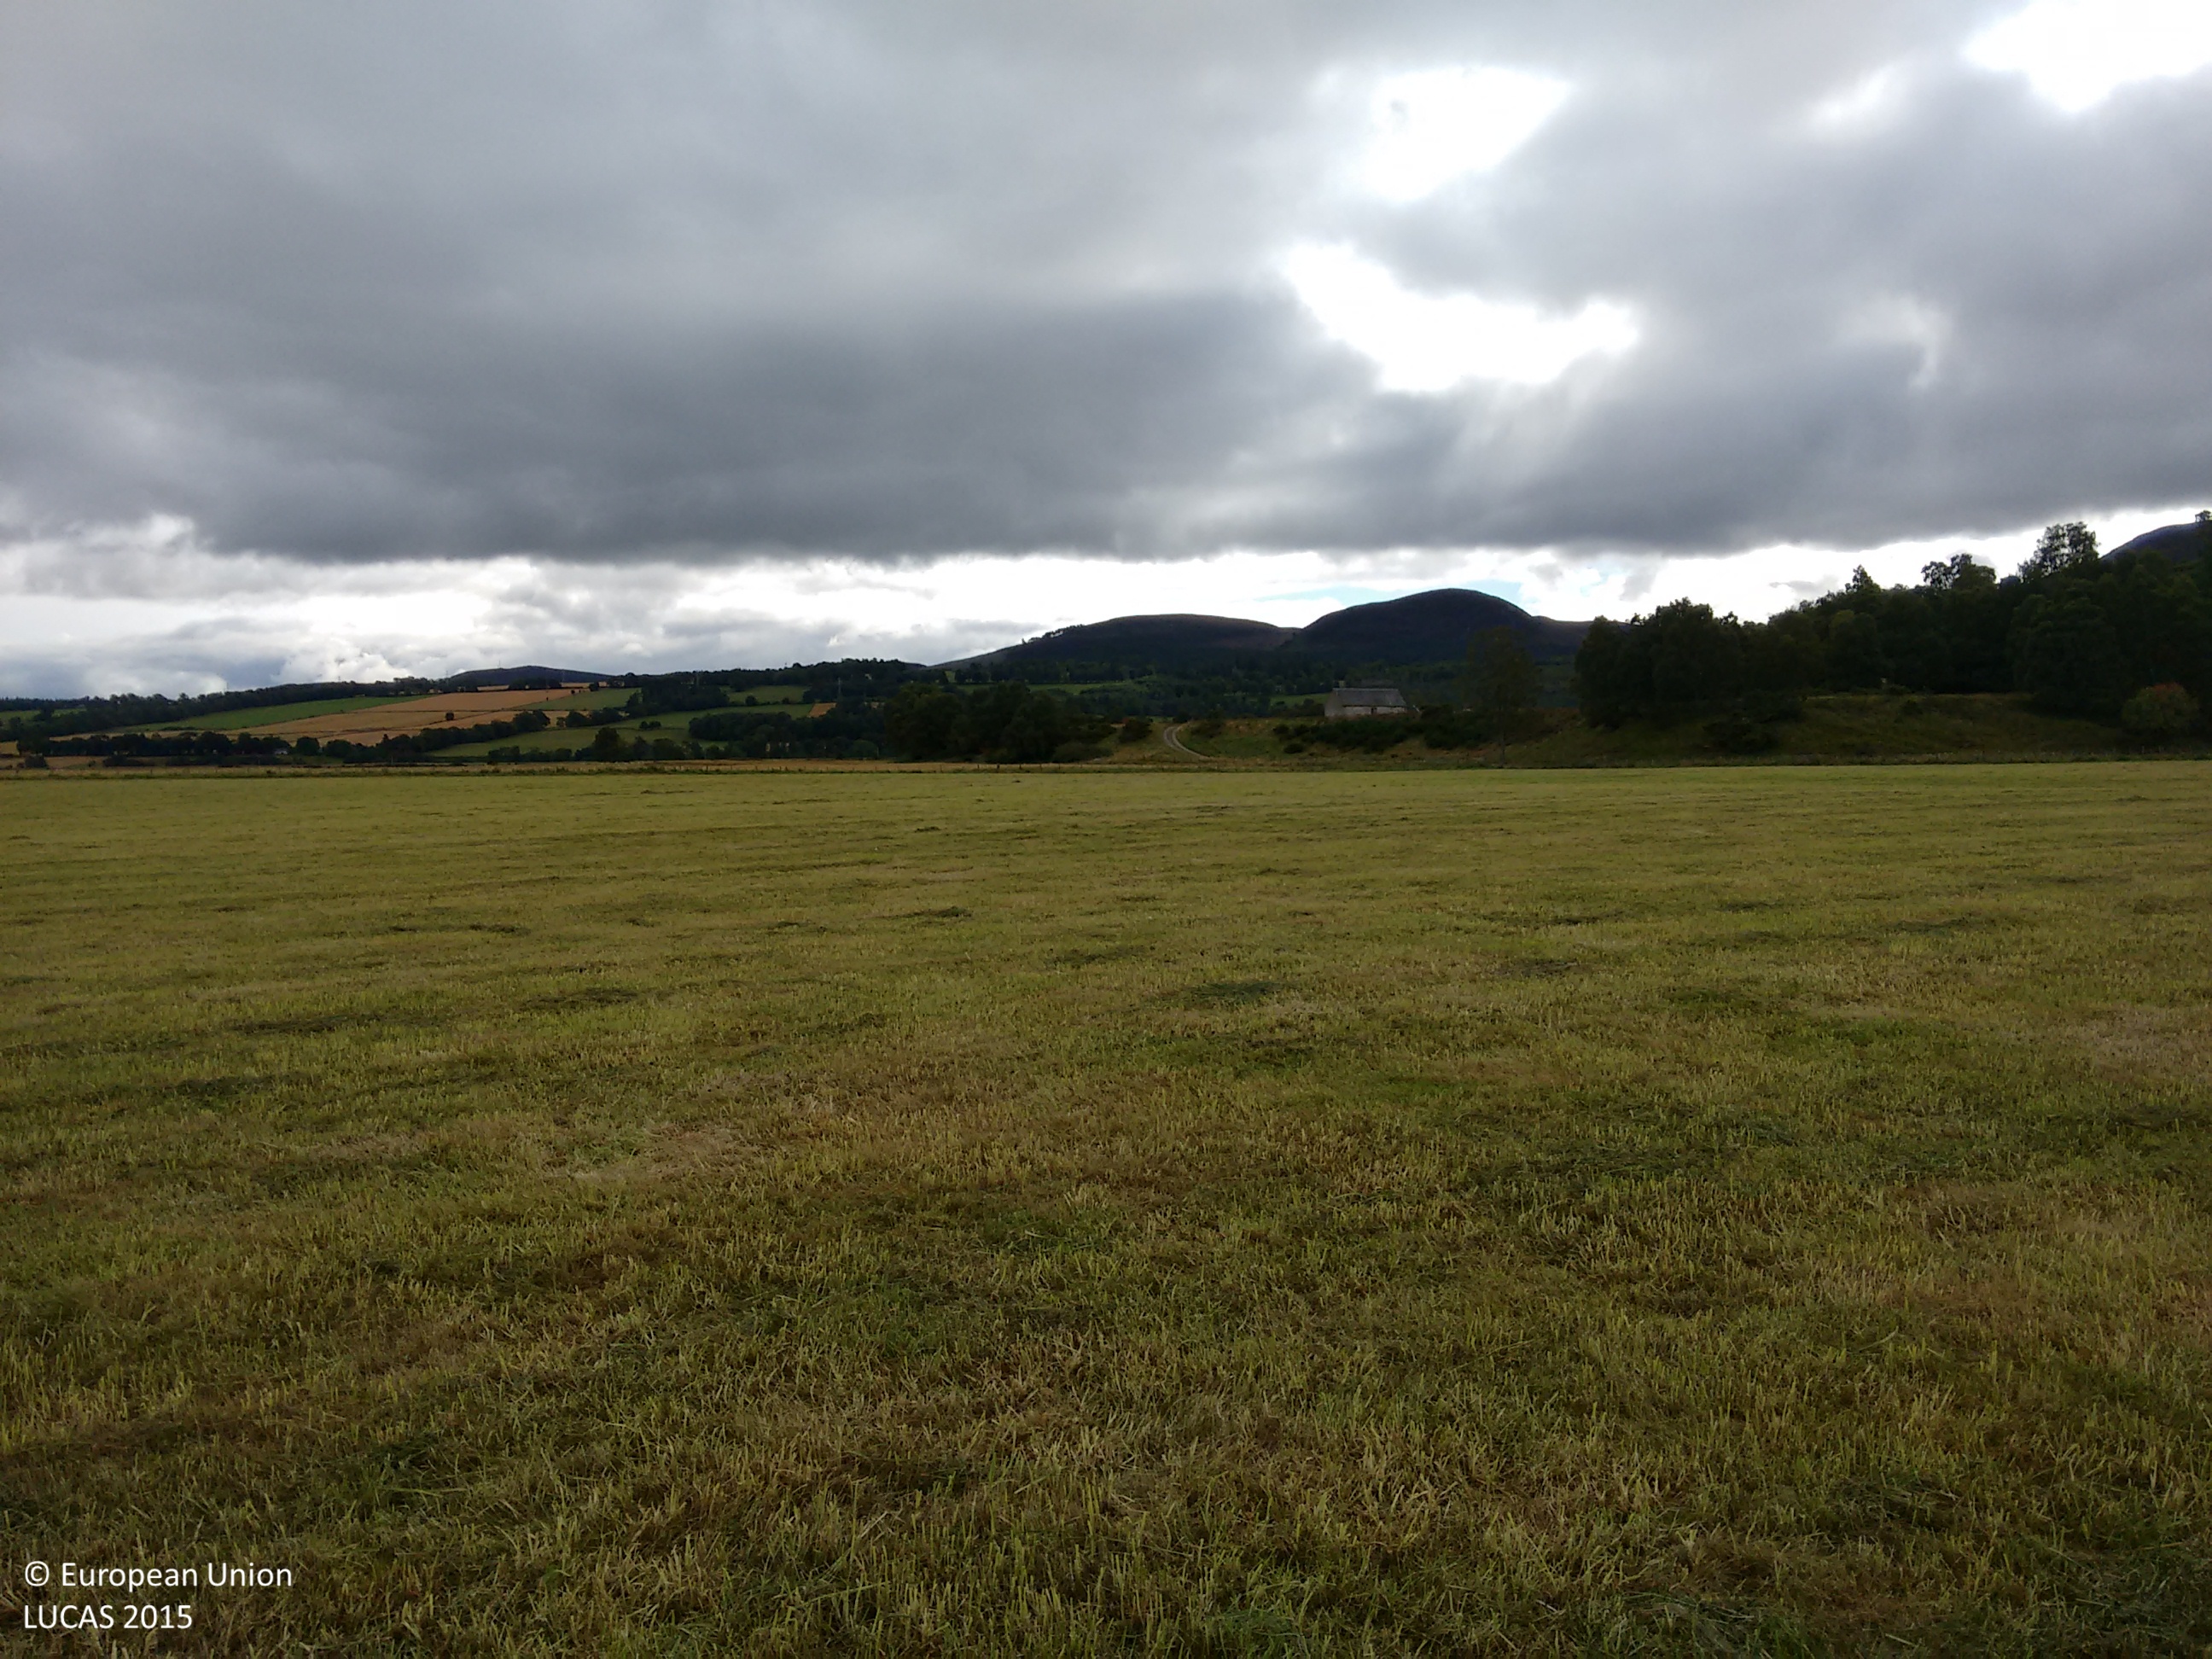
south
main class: Grassland
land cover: Grassland without tree/shrub cover
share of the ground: > 75 %
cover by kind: herbaceous plants 100 %
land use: Agriculture (excluding fallow land and kitchen gardens)
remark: Harvested field
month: September
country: GB
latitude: 57.5641
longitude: -4.5859
